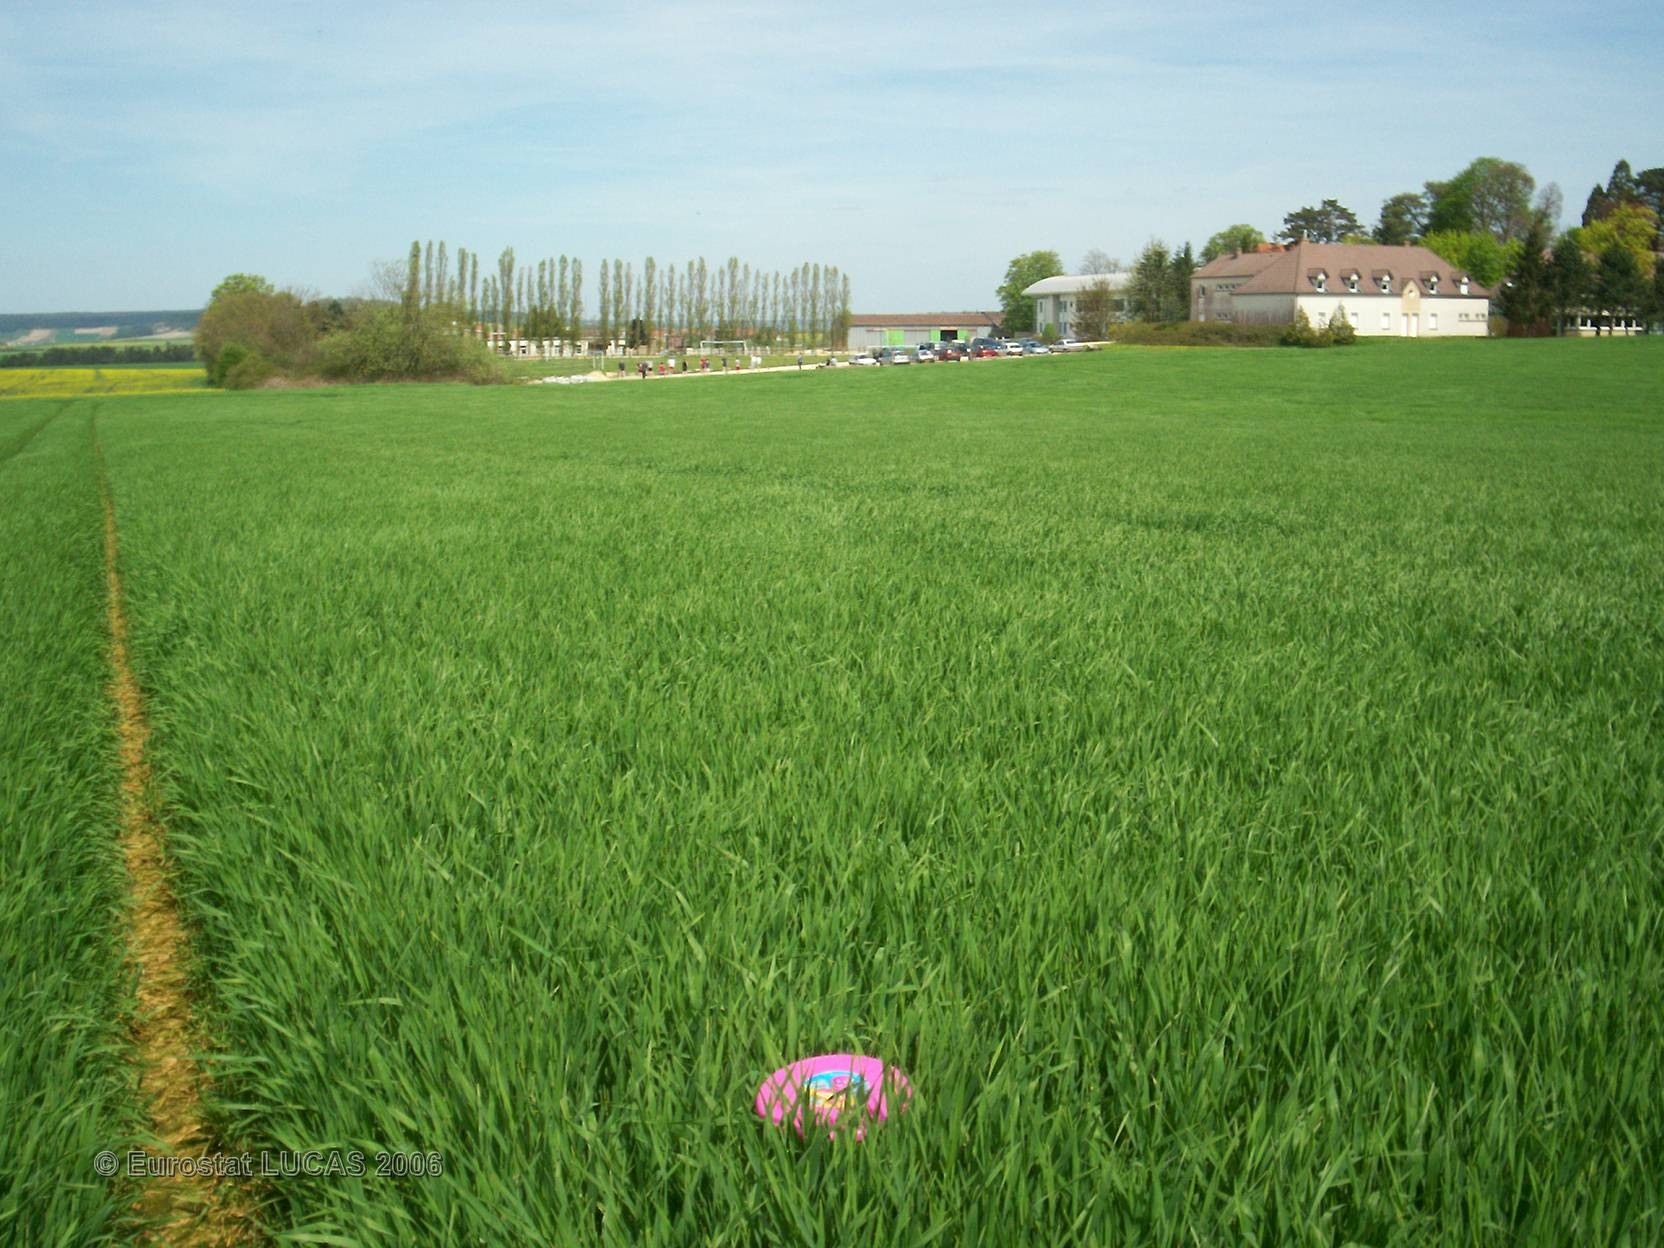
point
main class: Cropland
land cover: Barley
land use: Agriculture (excluding fallow land and kitchen gardens)
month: May
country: FR
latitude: 47.8574
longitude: 4.6121
